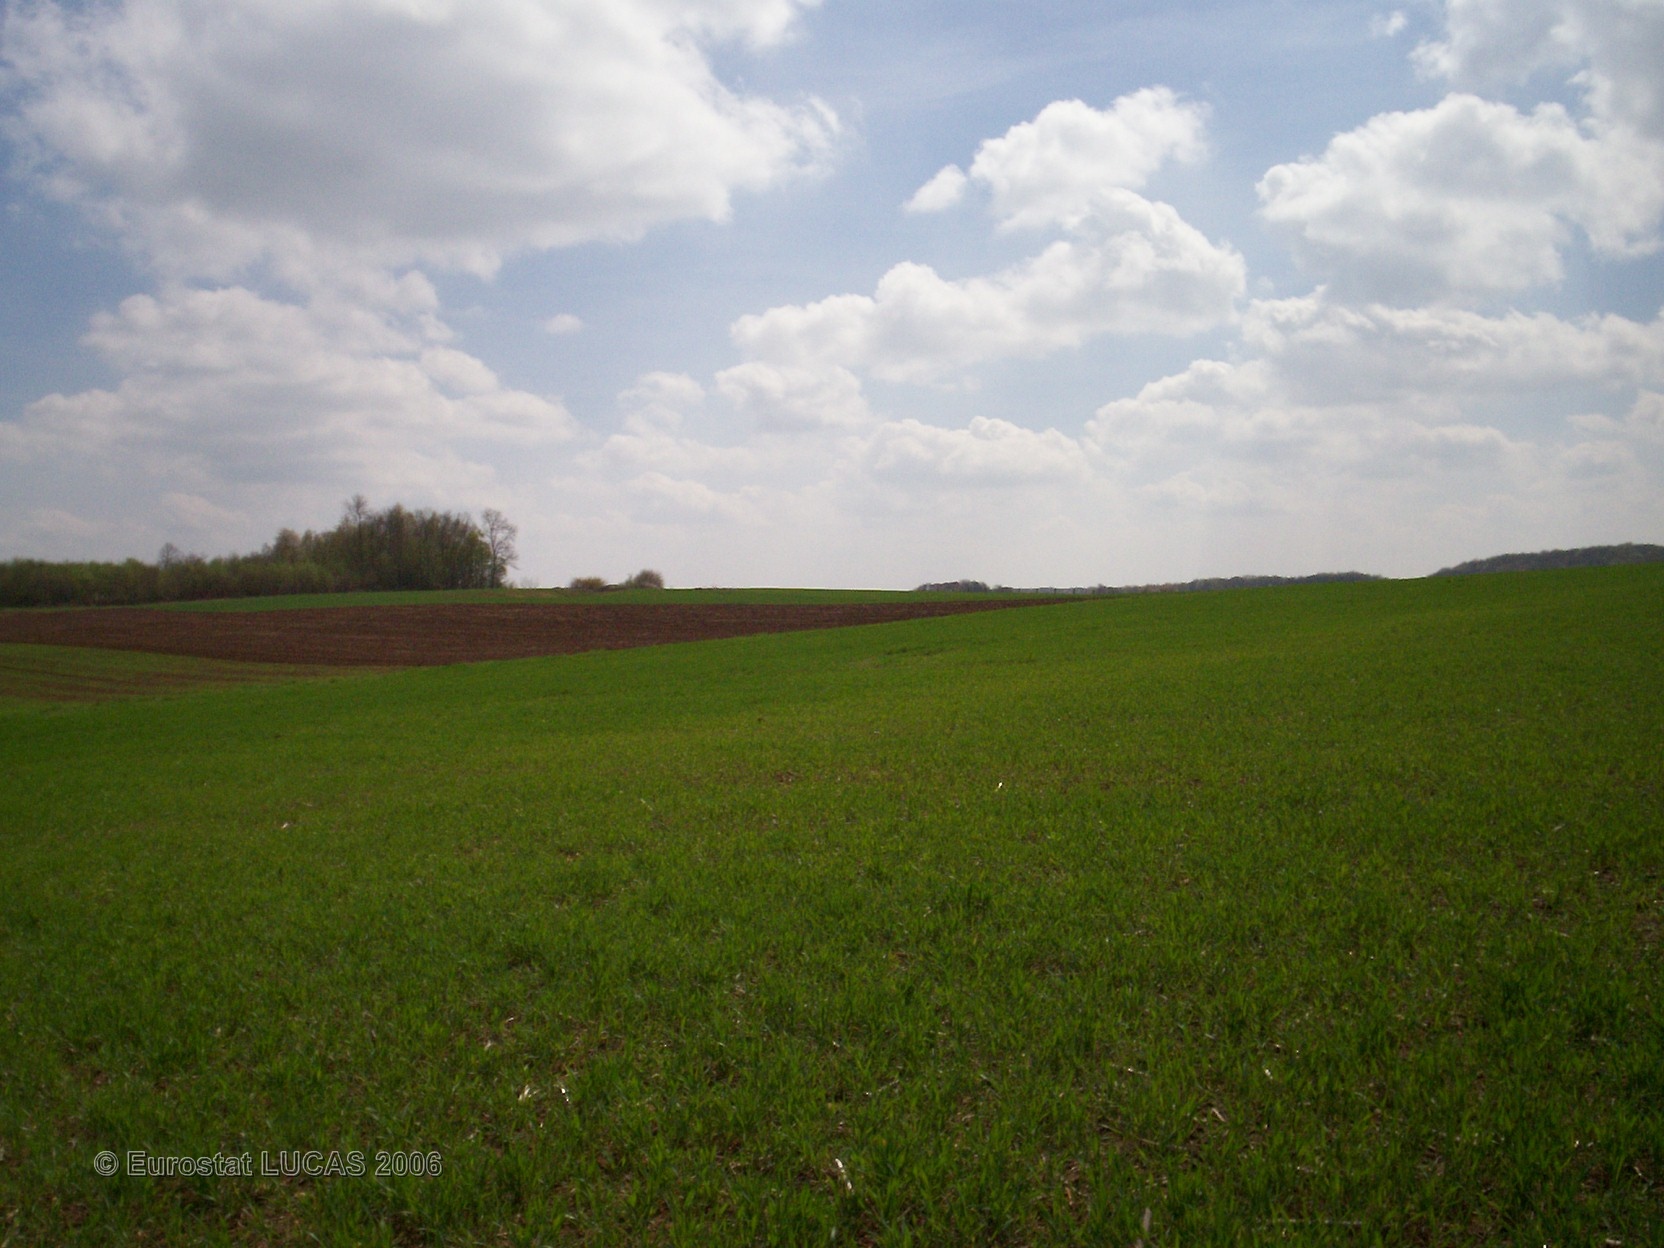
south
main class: Cropland
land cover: Common wheat
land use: Agriculture (excluding fallow land and kitchen gardens)
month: May
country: FR
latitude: 49.7928
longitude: 4.3697
